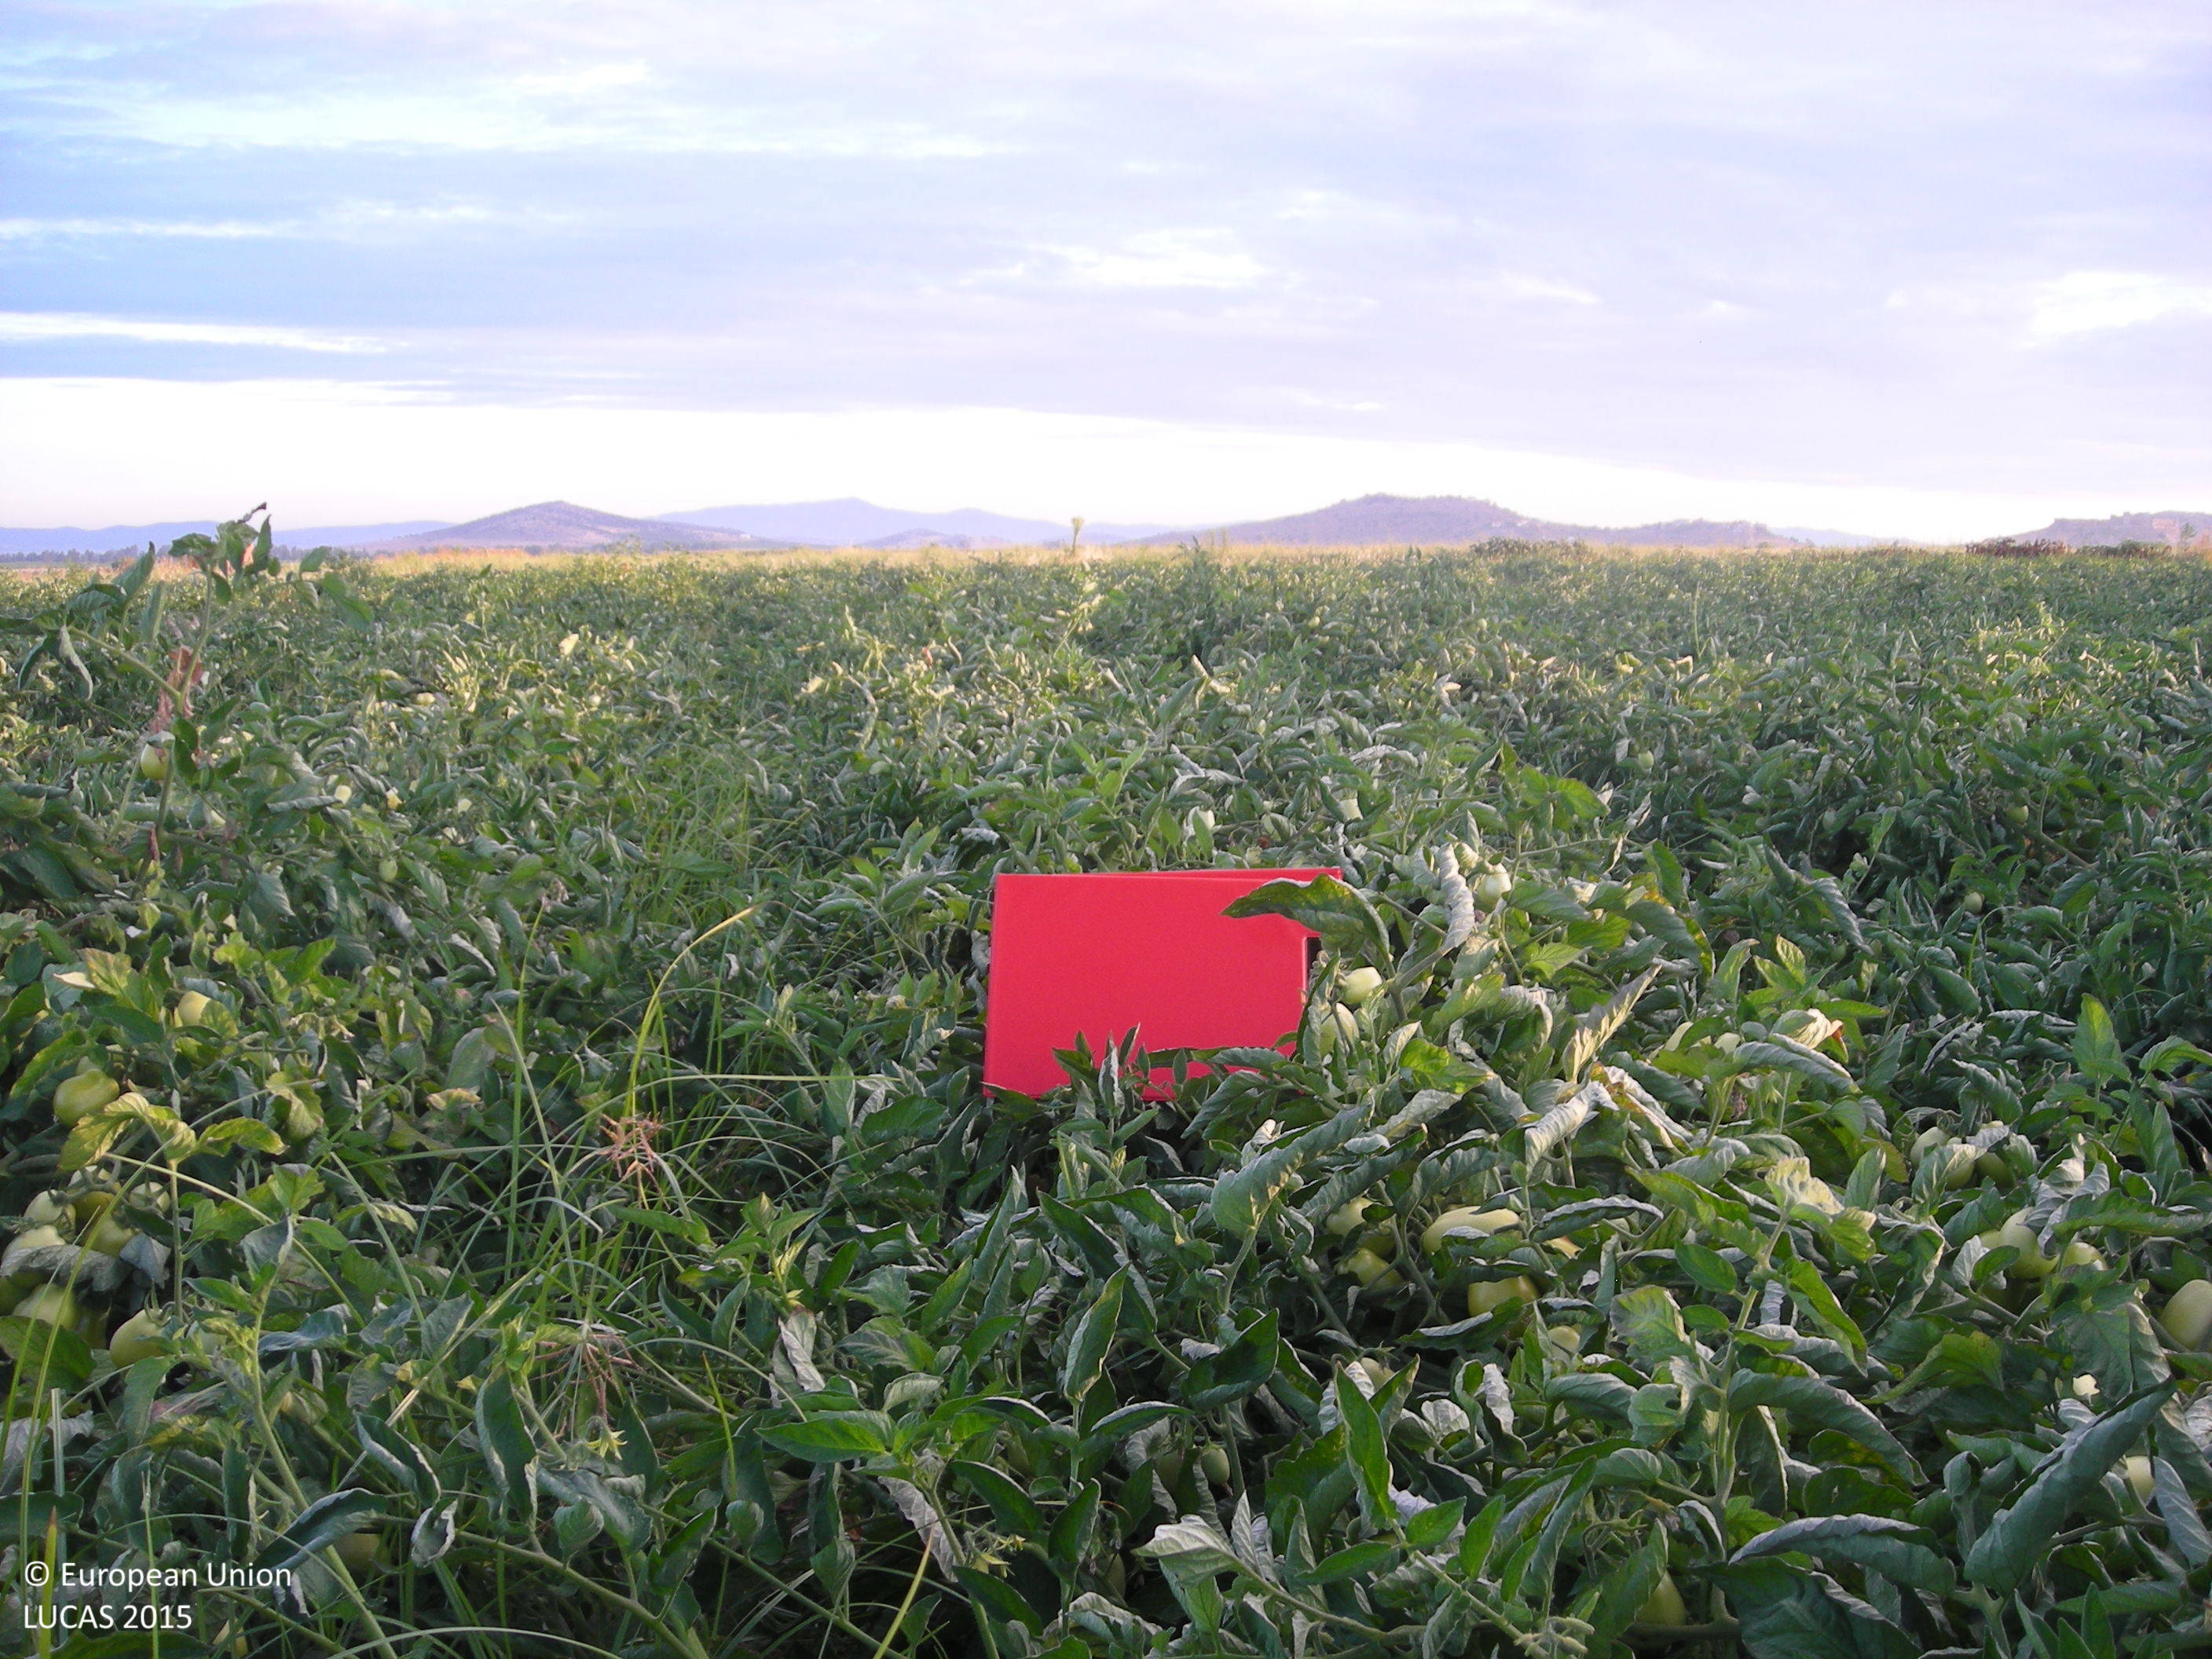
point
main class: Cropland
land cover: Tomatoes
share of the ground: > 75 %
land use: Agriculture (excluding fallow land and kitchen gardens)
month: July
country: ES
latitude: 38.9331
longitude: -5.9586
